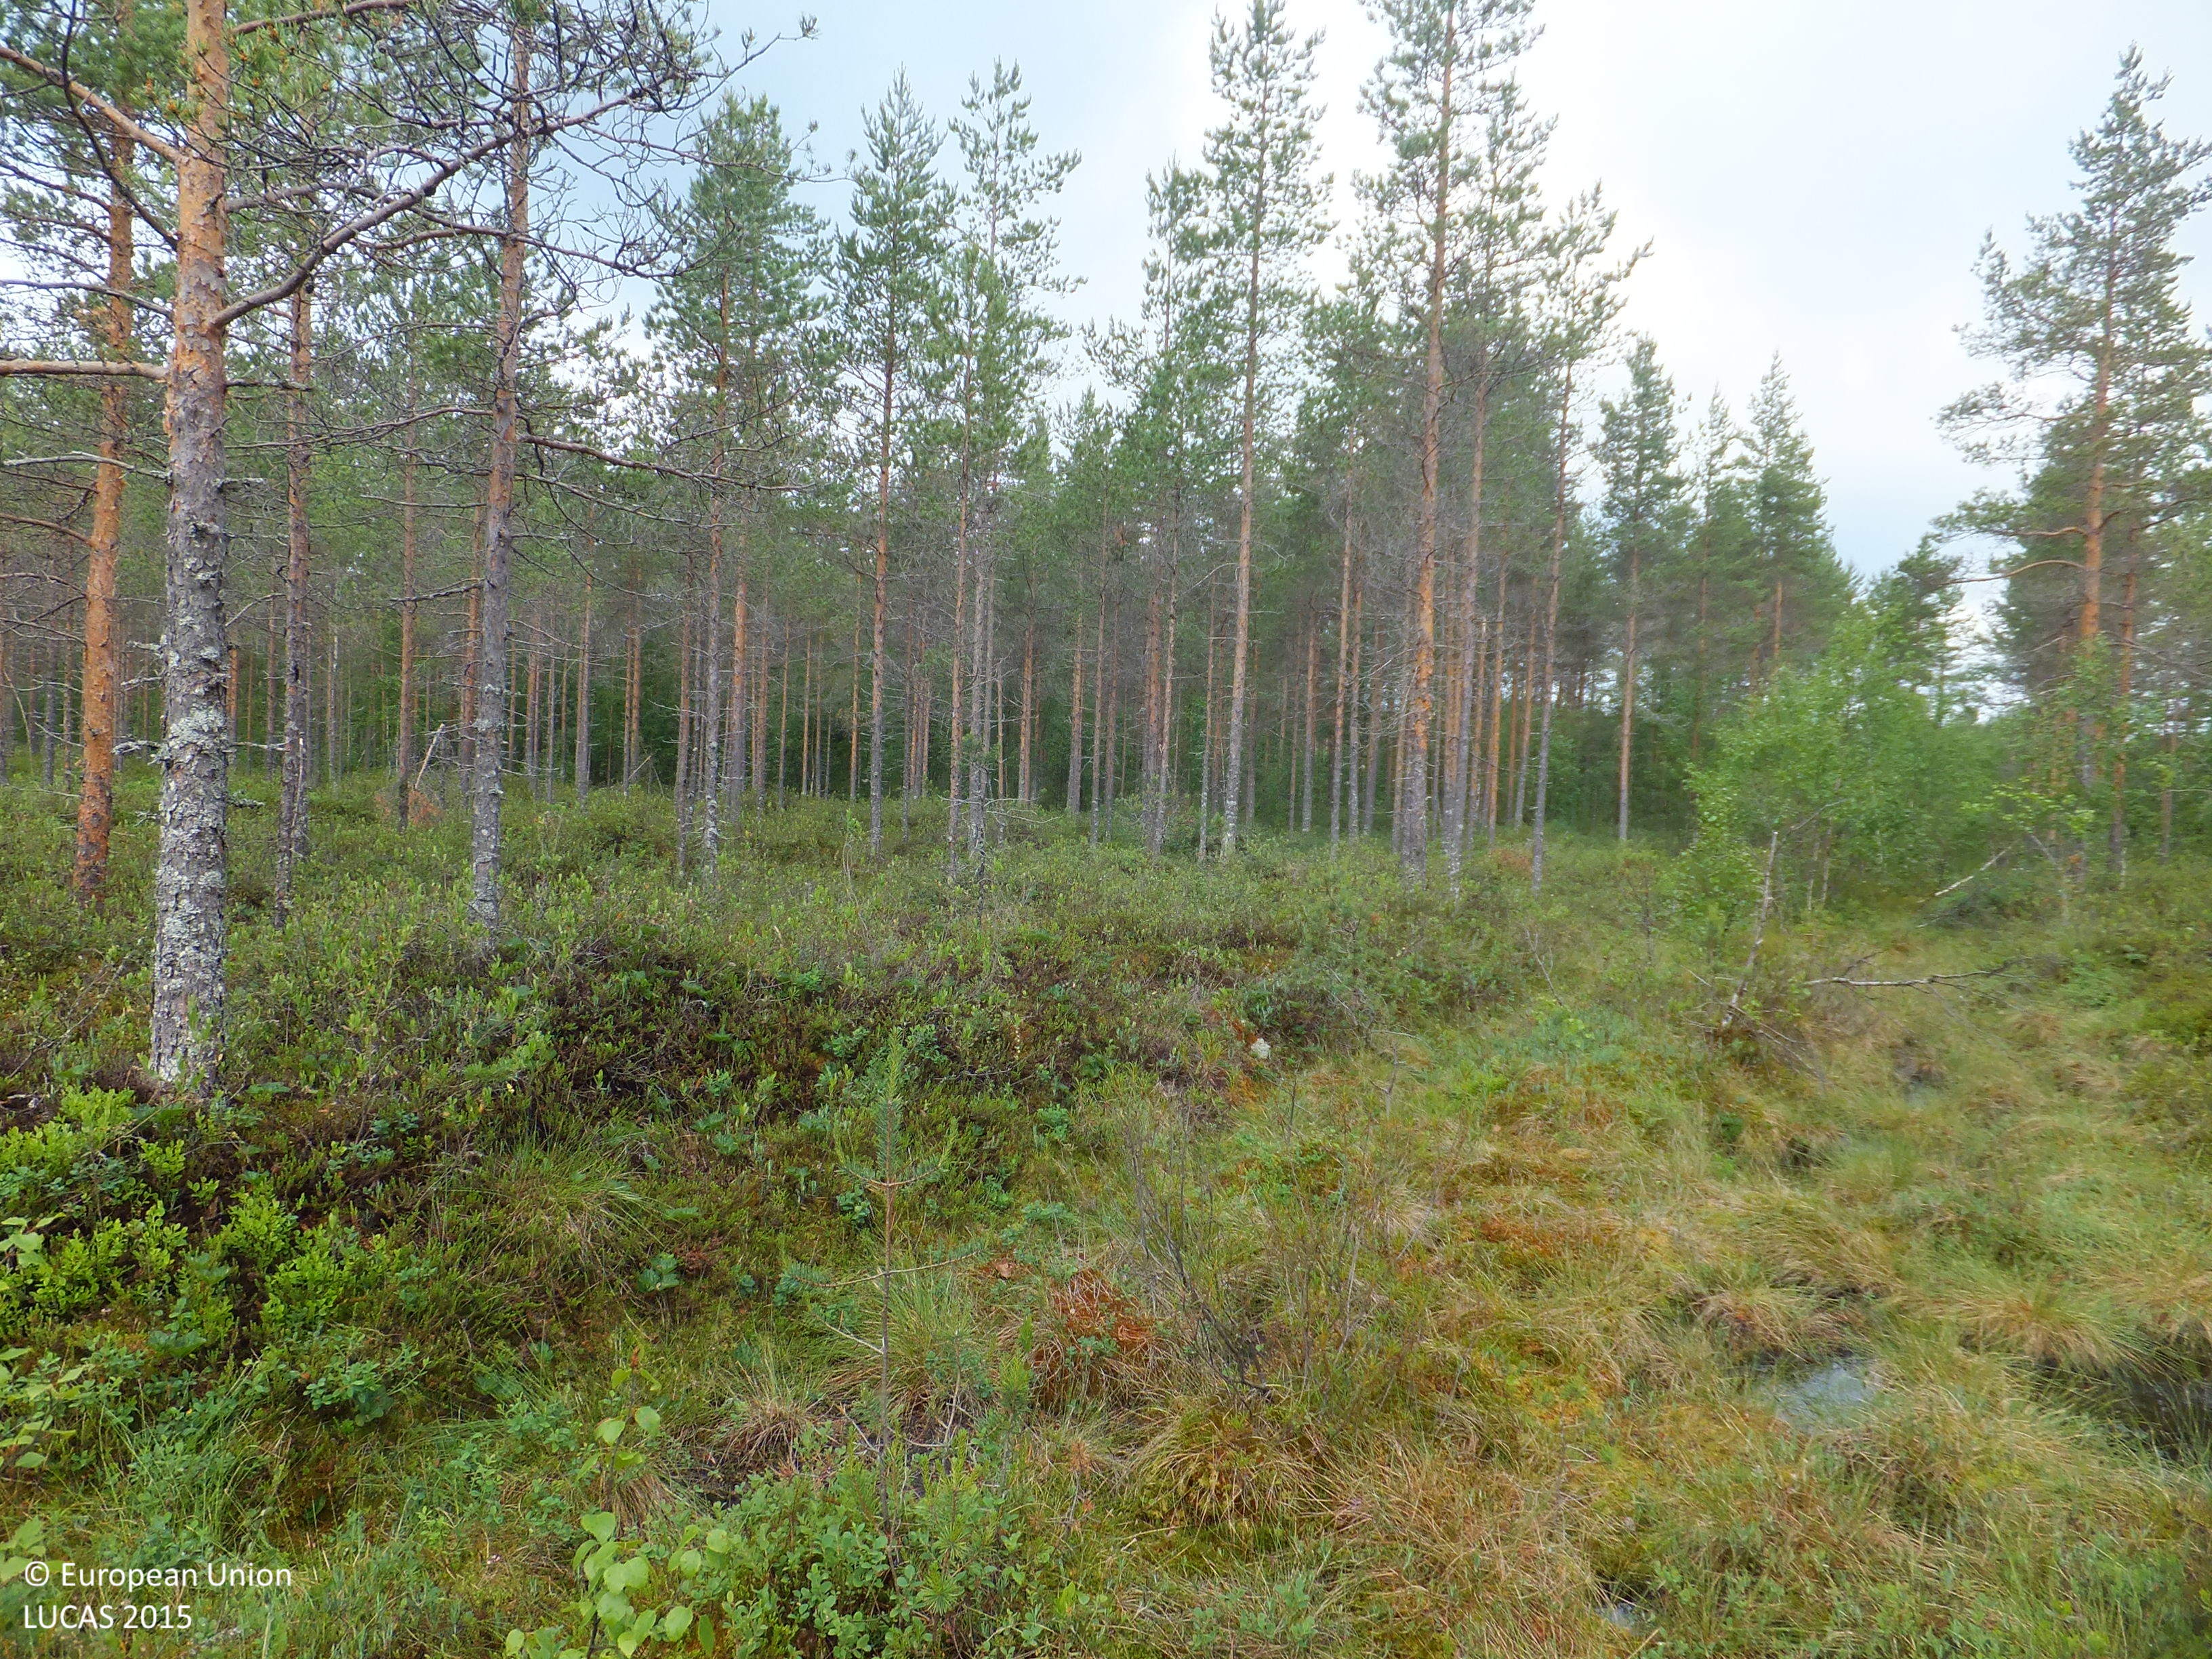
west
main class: Woodland
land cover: Pine dominated mixed woodland
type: mire and swamp forests
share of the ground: 50 - 75 %
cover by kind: broadleaved forest trees 35 %, shrubs 30 %, coniferous forest trees 20 %, lichens and mosses 10 %, herbaceous plants 5 %
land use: Forestry
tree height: > 5 m
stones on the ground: < 10 %
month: July
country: FI
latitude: 63.4871
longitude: 24.3123
